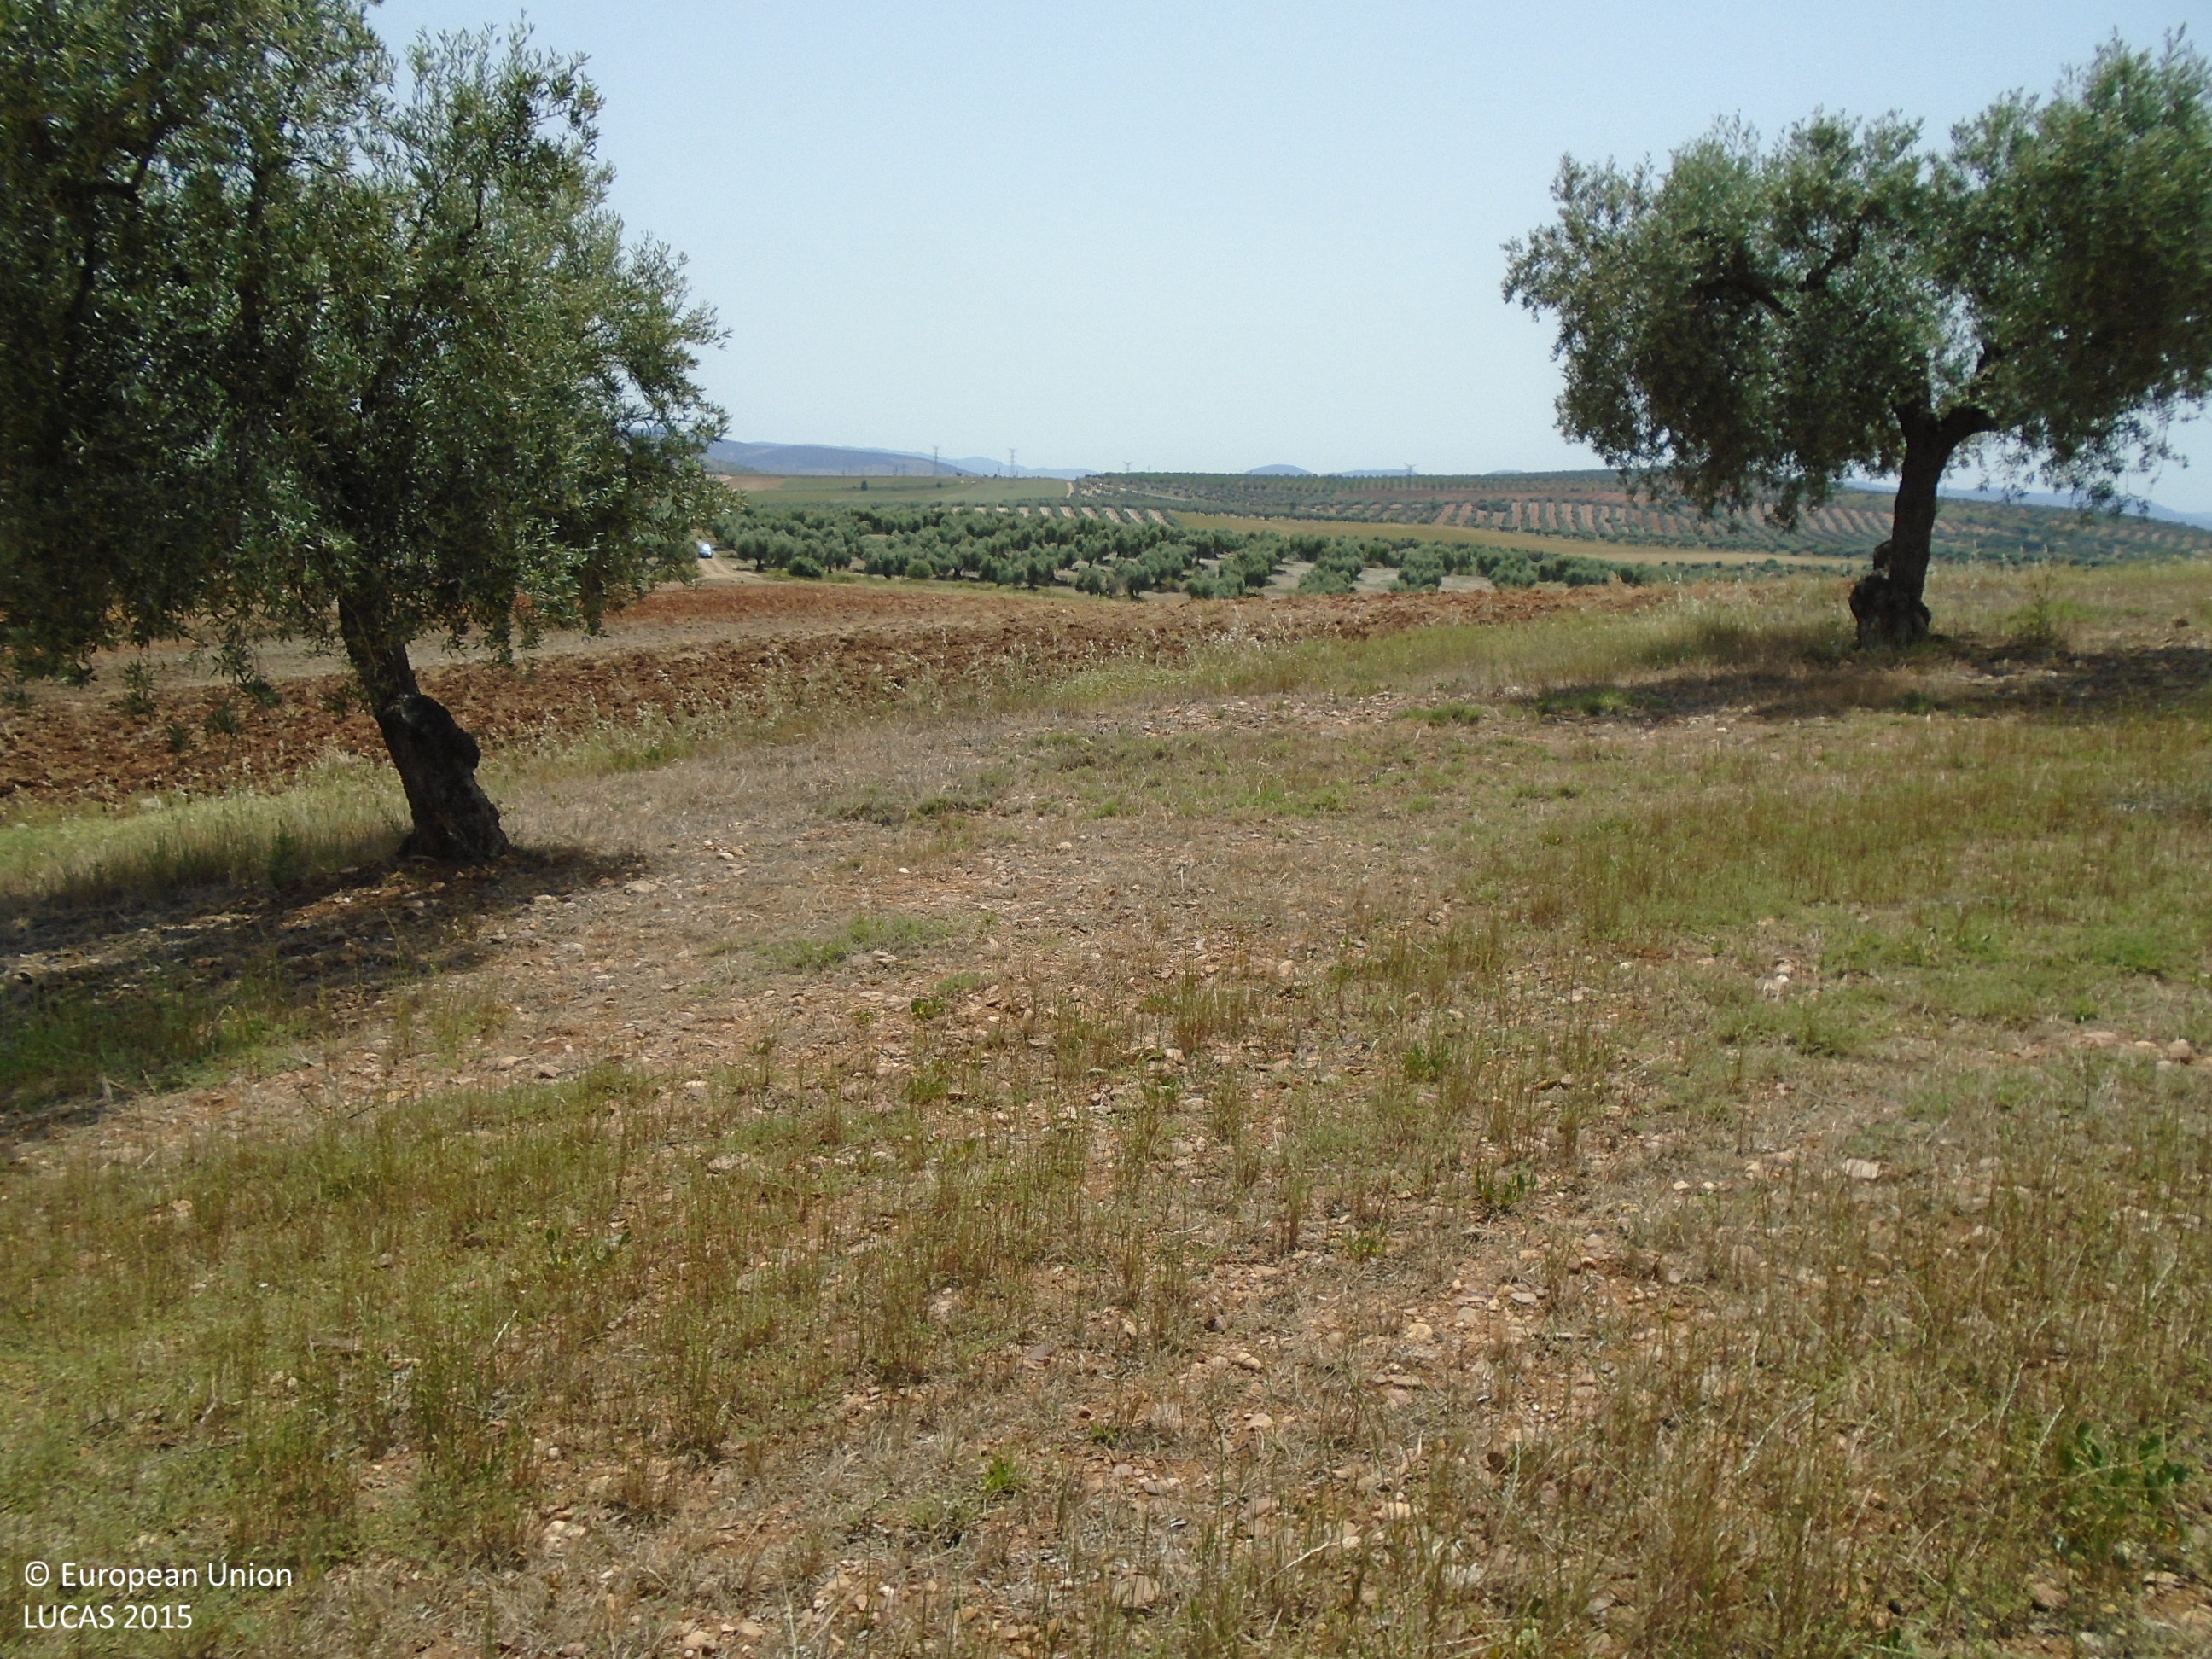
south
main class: Cropland
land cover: Olive groves
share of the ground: 10 - 25 %
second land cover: Spontaneously vegetated surfaces
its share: > 75 %
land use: Agriculture (excluding fallow land and kitchen gardens)
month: May
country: ES
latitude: 39.7496
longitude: -4.6418
